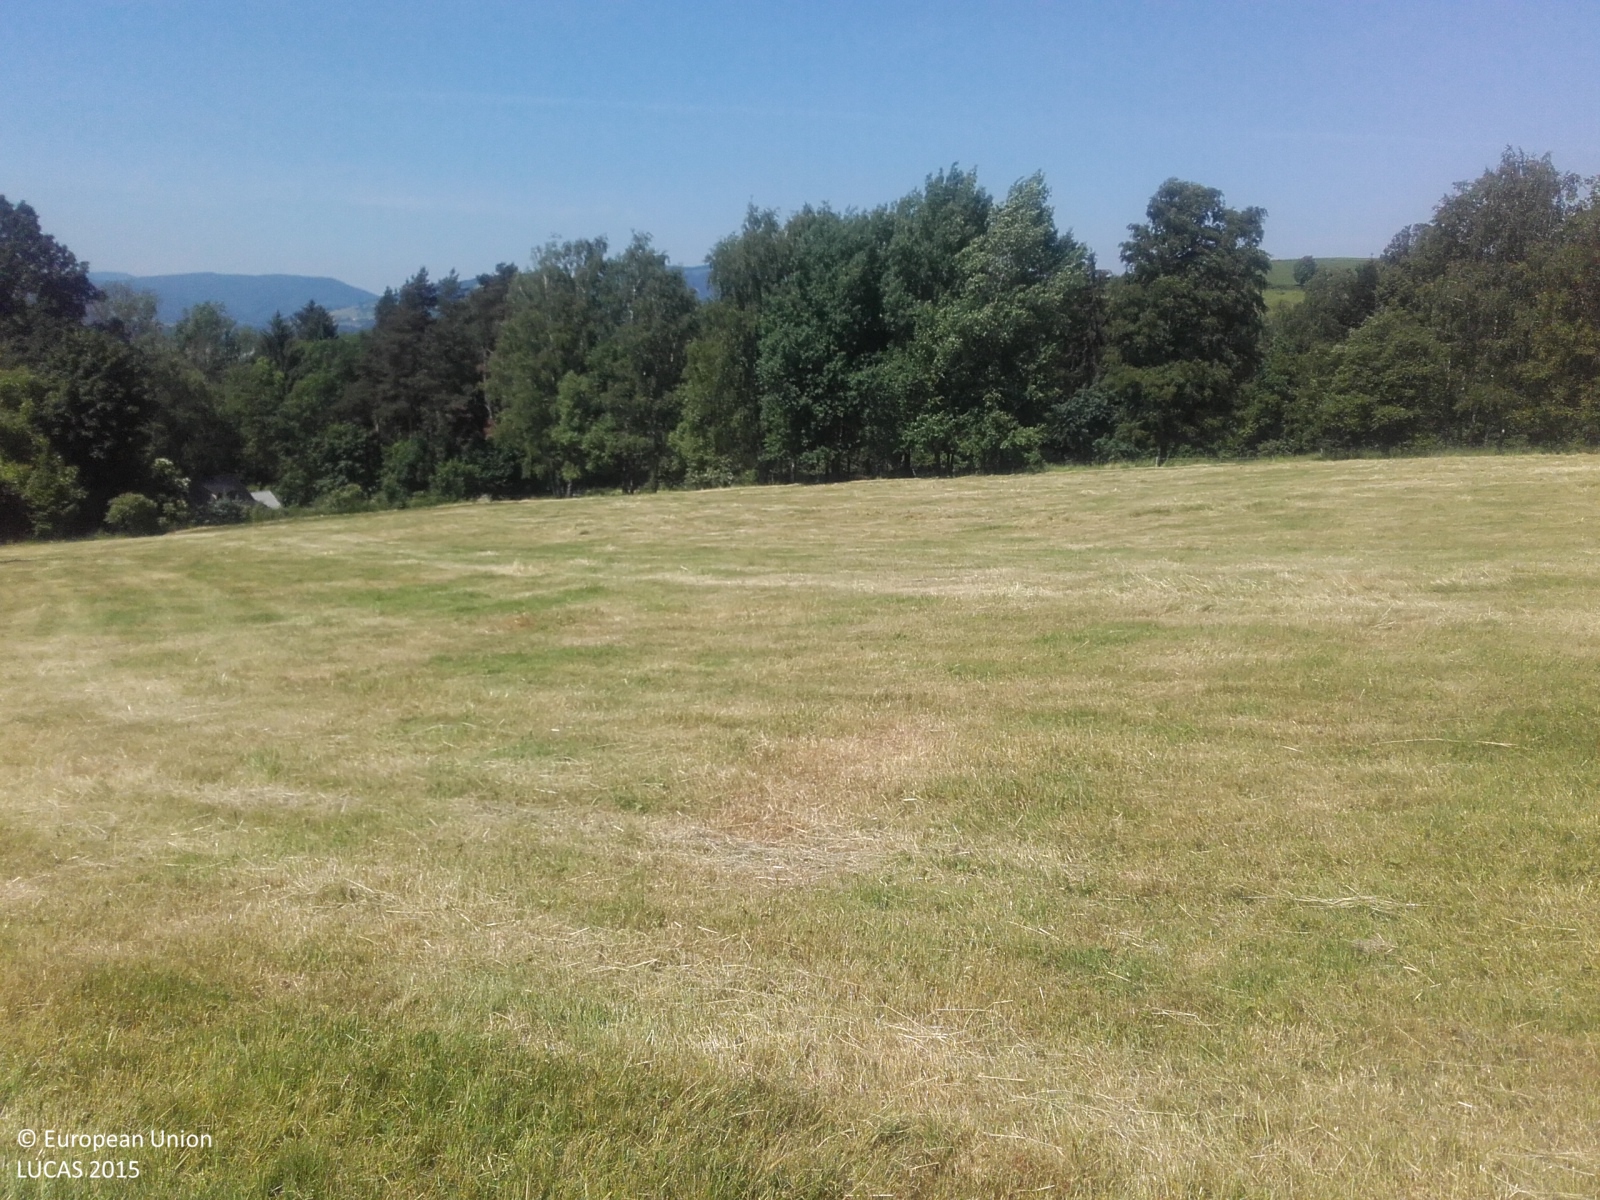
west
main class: Grassland
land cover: Grassland without tree/shrub cover
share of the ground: > 75 %
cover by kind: herbaceous plants 100 %
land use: Agriculture (excluding fallow land and kitchen gardens)
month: June
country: CZ
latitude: 49.5720
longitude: 18.8018
